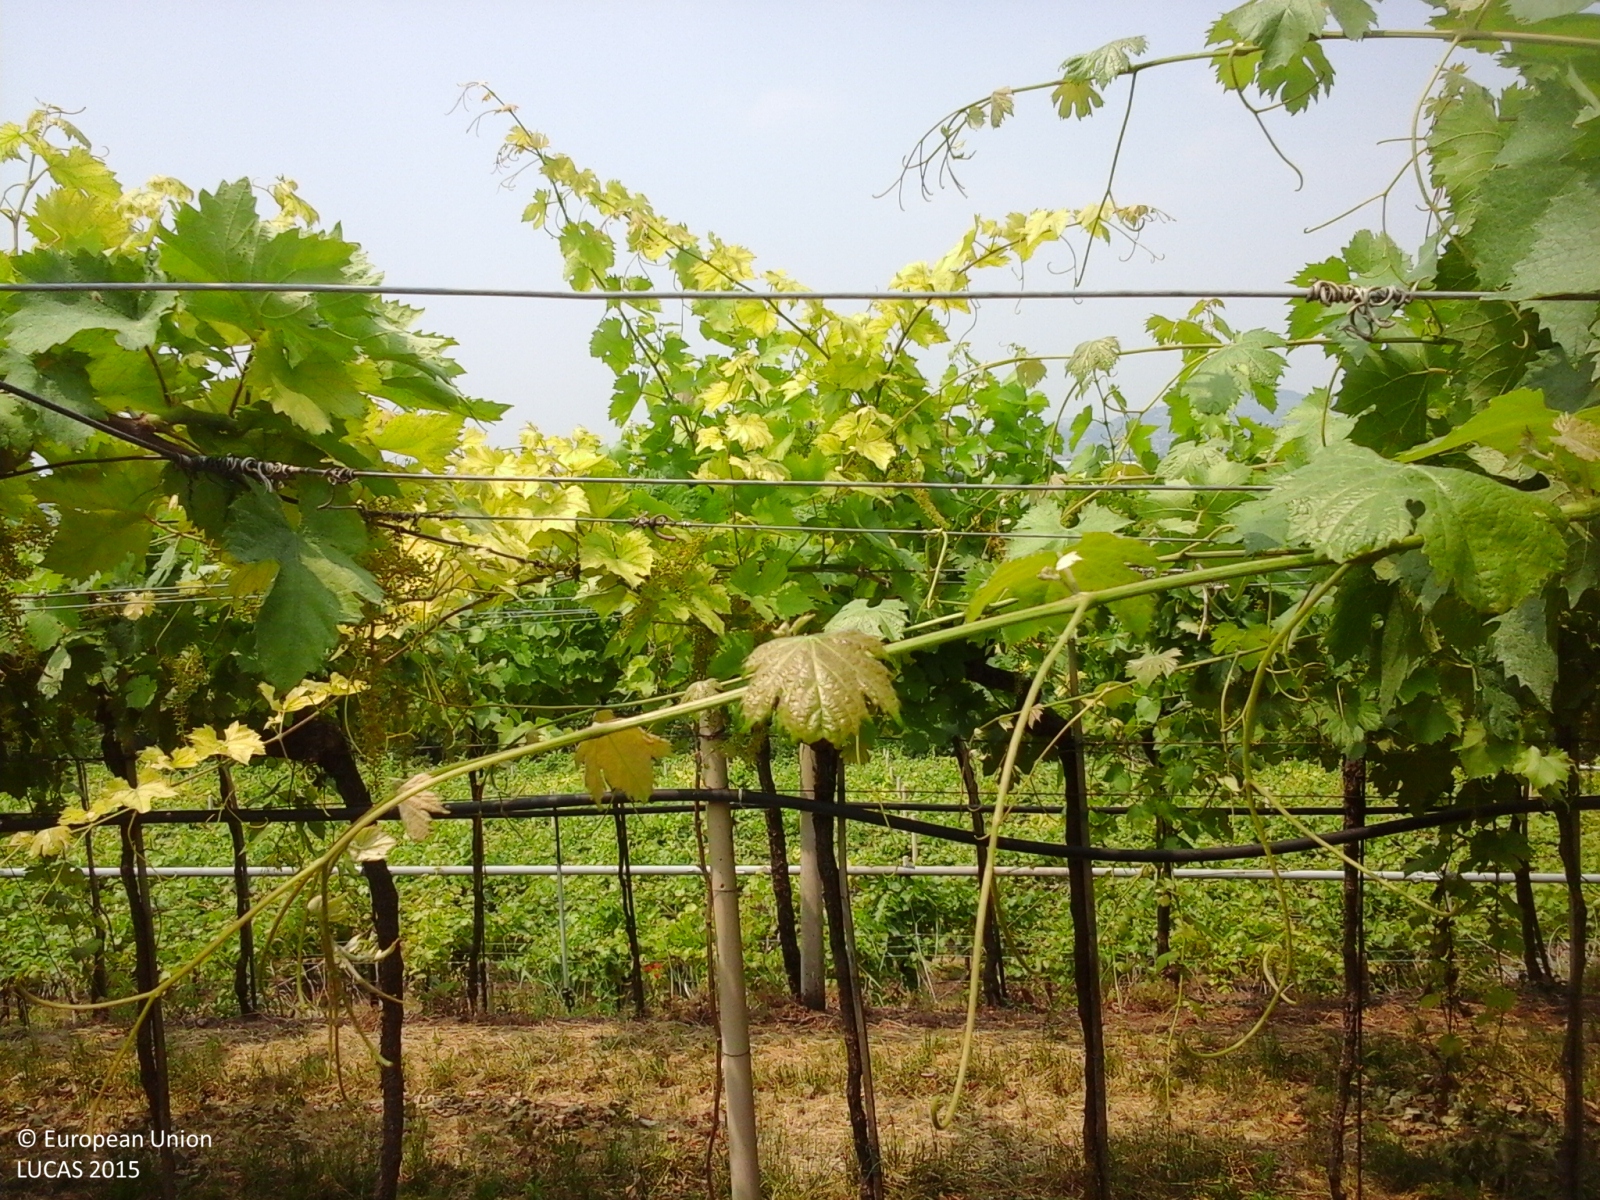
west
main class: Cropland
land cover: Vineyards
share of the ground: 50 - 75 %
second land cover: Grassland without tree/shrub cover
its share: > 75 %
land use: Agriculture (excluding fallow land and kitchen gardens)
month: June
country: IT
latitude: 45.4256
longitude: 11.1866
